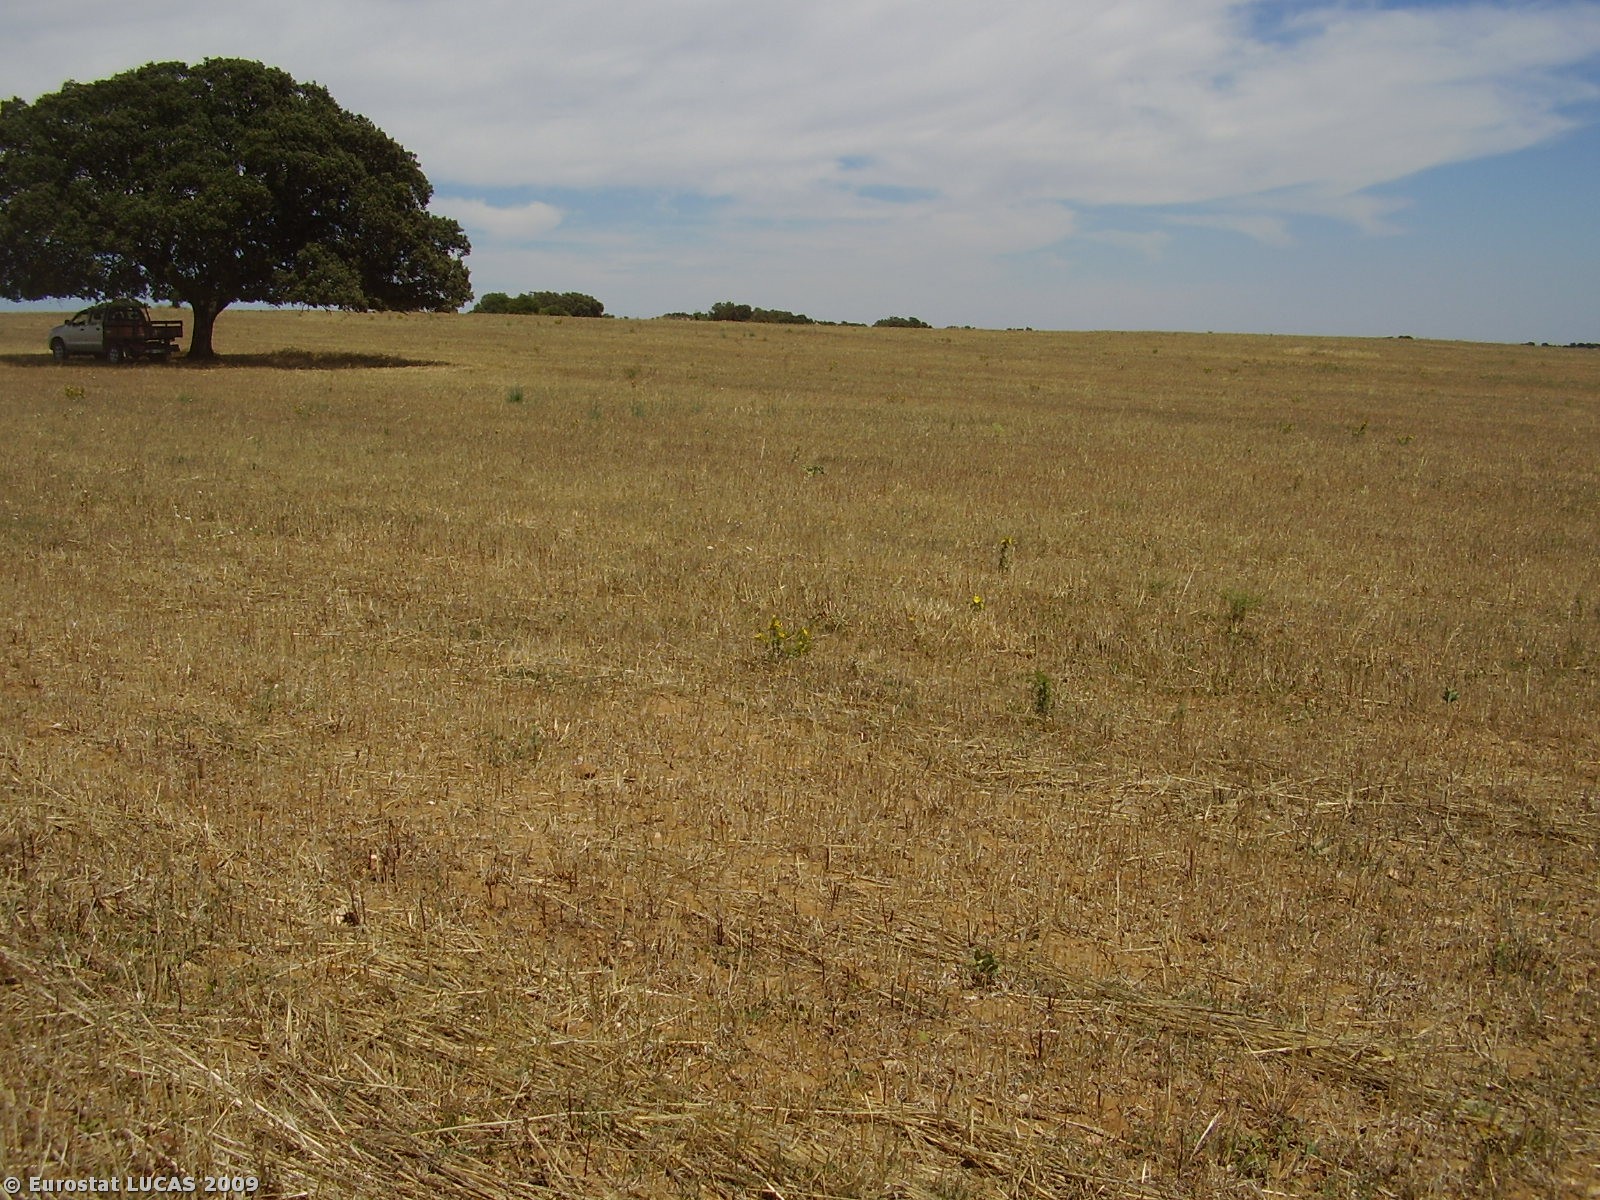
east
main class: Cropland
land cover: Common wheat
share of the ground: > 75 %
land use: Agriculture (excluding fallow land and kitchen gardens)
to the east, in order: Common wheat; Rock outcrops
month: July
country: PT
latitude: 38.6811
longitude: -7.8934
